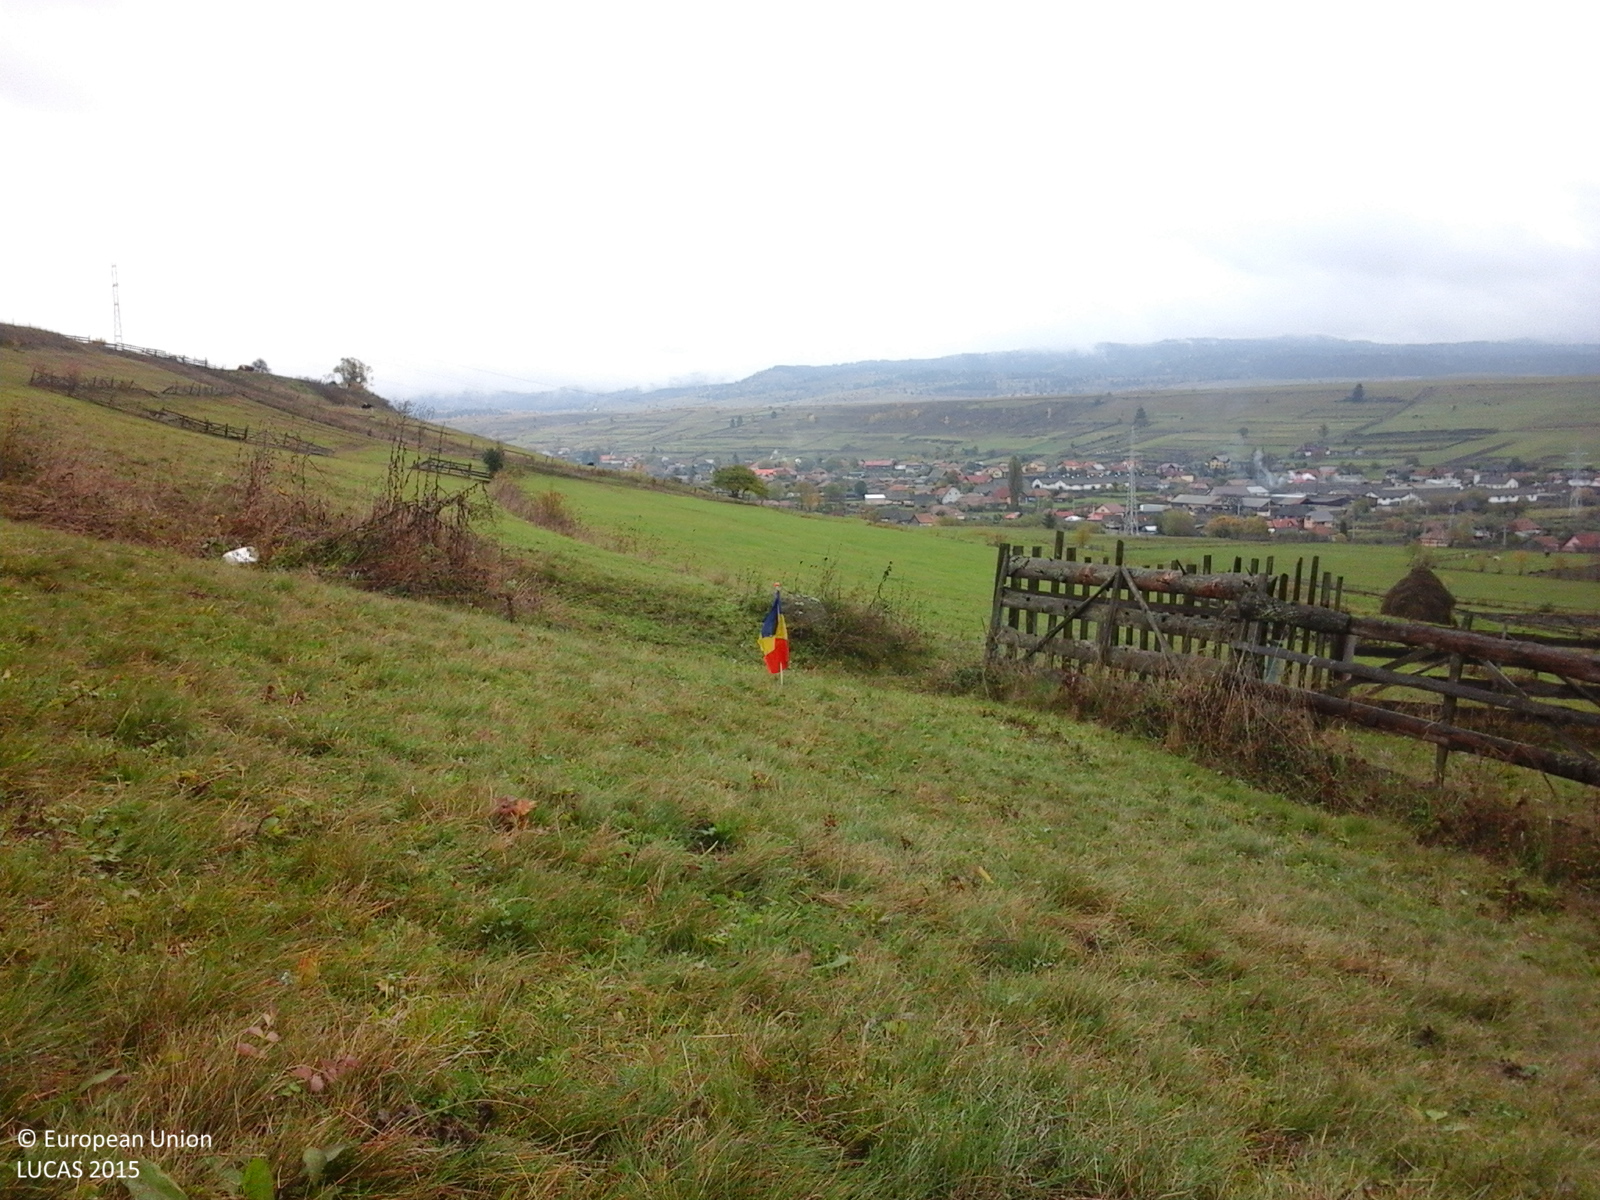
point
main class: Grassland
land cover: Grassland without tree/shrub cover
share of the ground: > 75 %
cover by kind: herbaceous plants 100 %
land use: Agriculture (excluding fallow land and kitchen gardens)
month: October
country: RO
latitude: 46.9373
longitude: 25.3594
